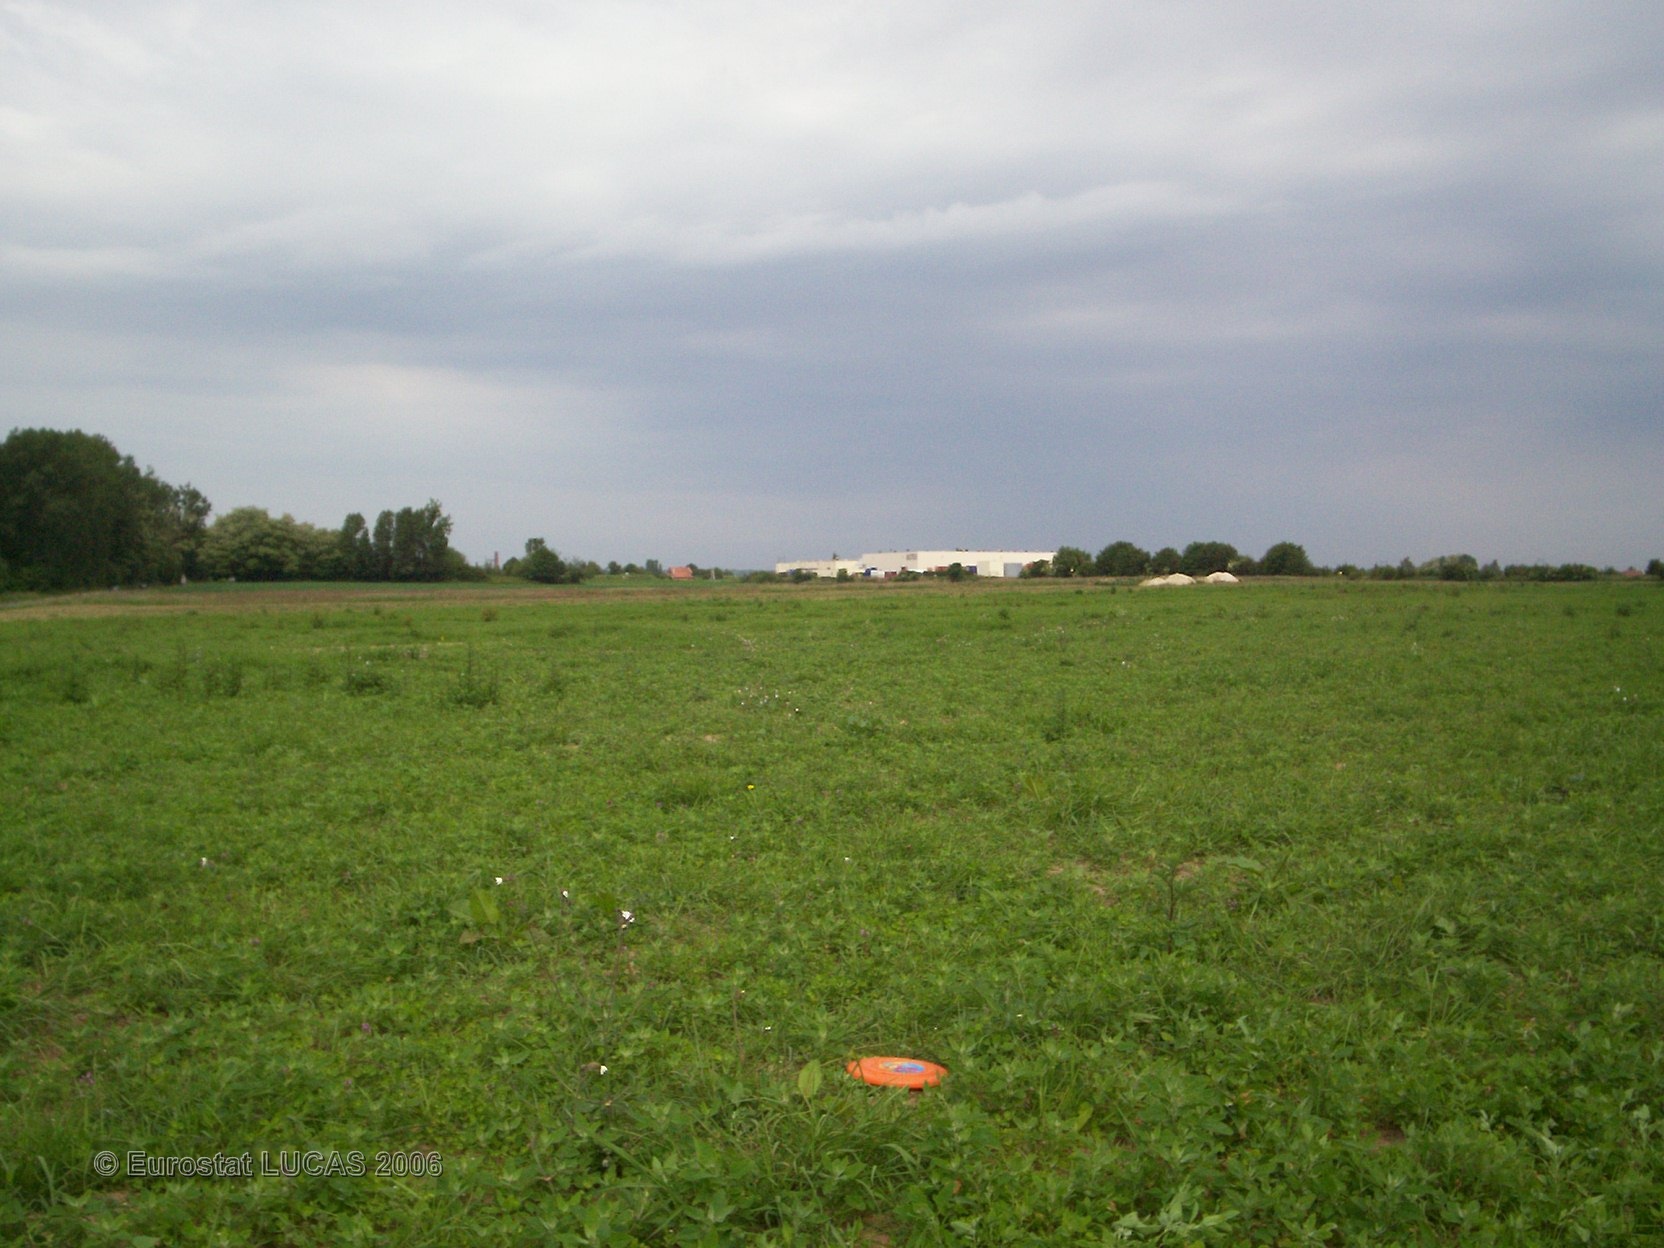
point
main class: Grassland
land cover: Grassland without tree/shrub cover
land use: Agriculture (excluding fallow land and kitchen gardens)
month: June
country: FR
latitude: 49.4279
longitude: 2.7232
